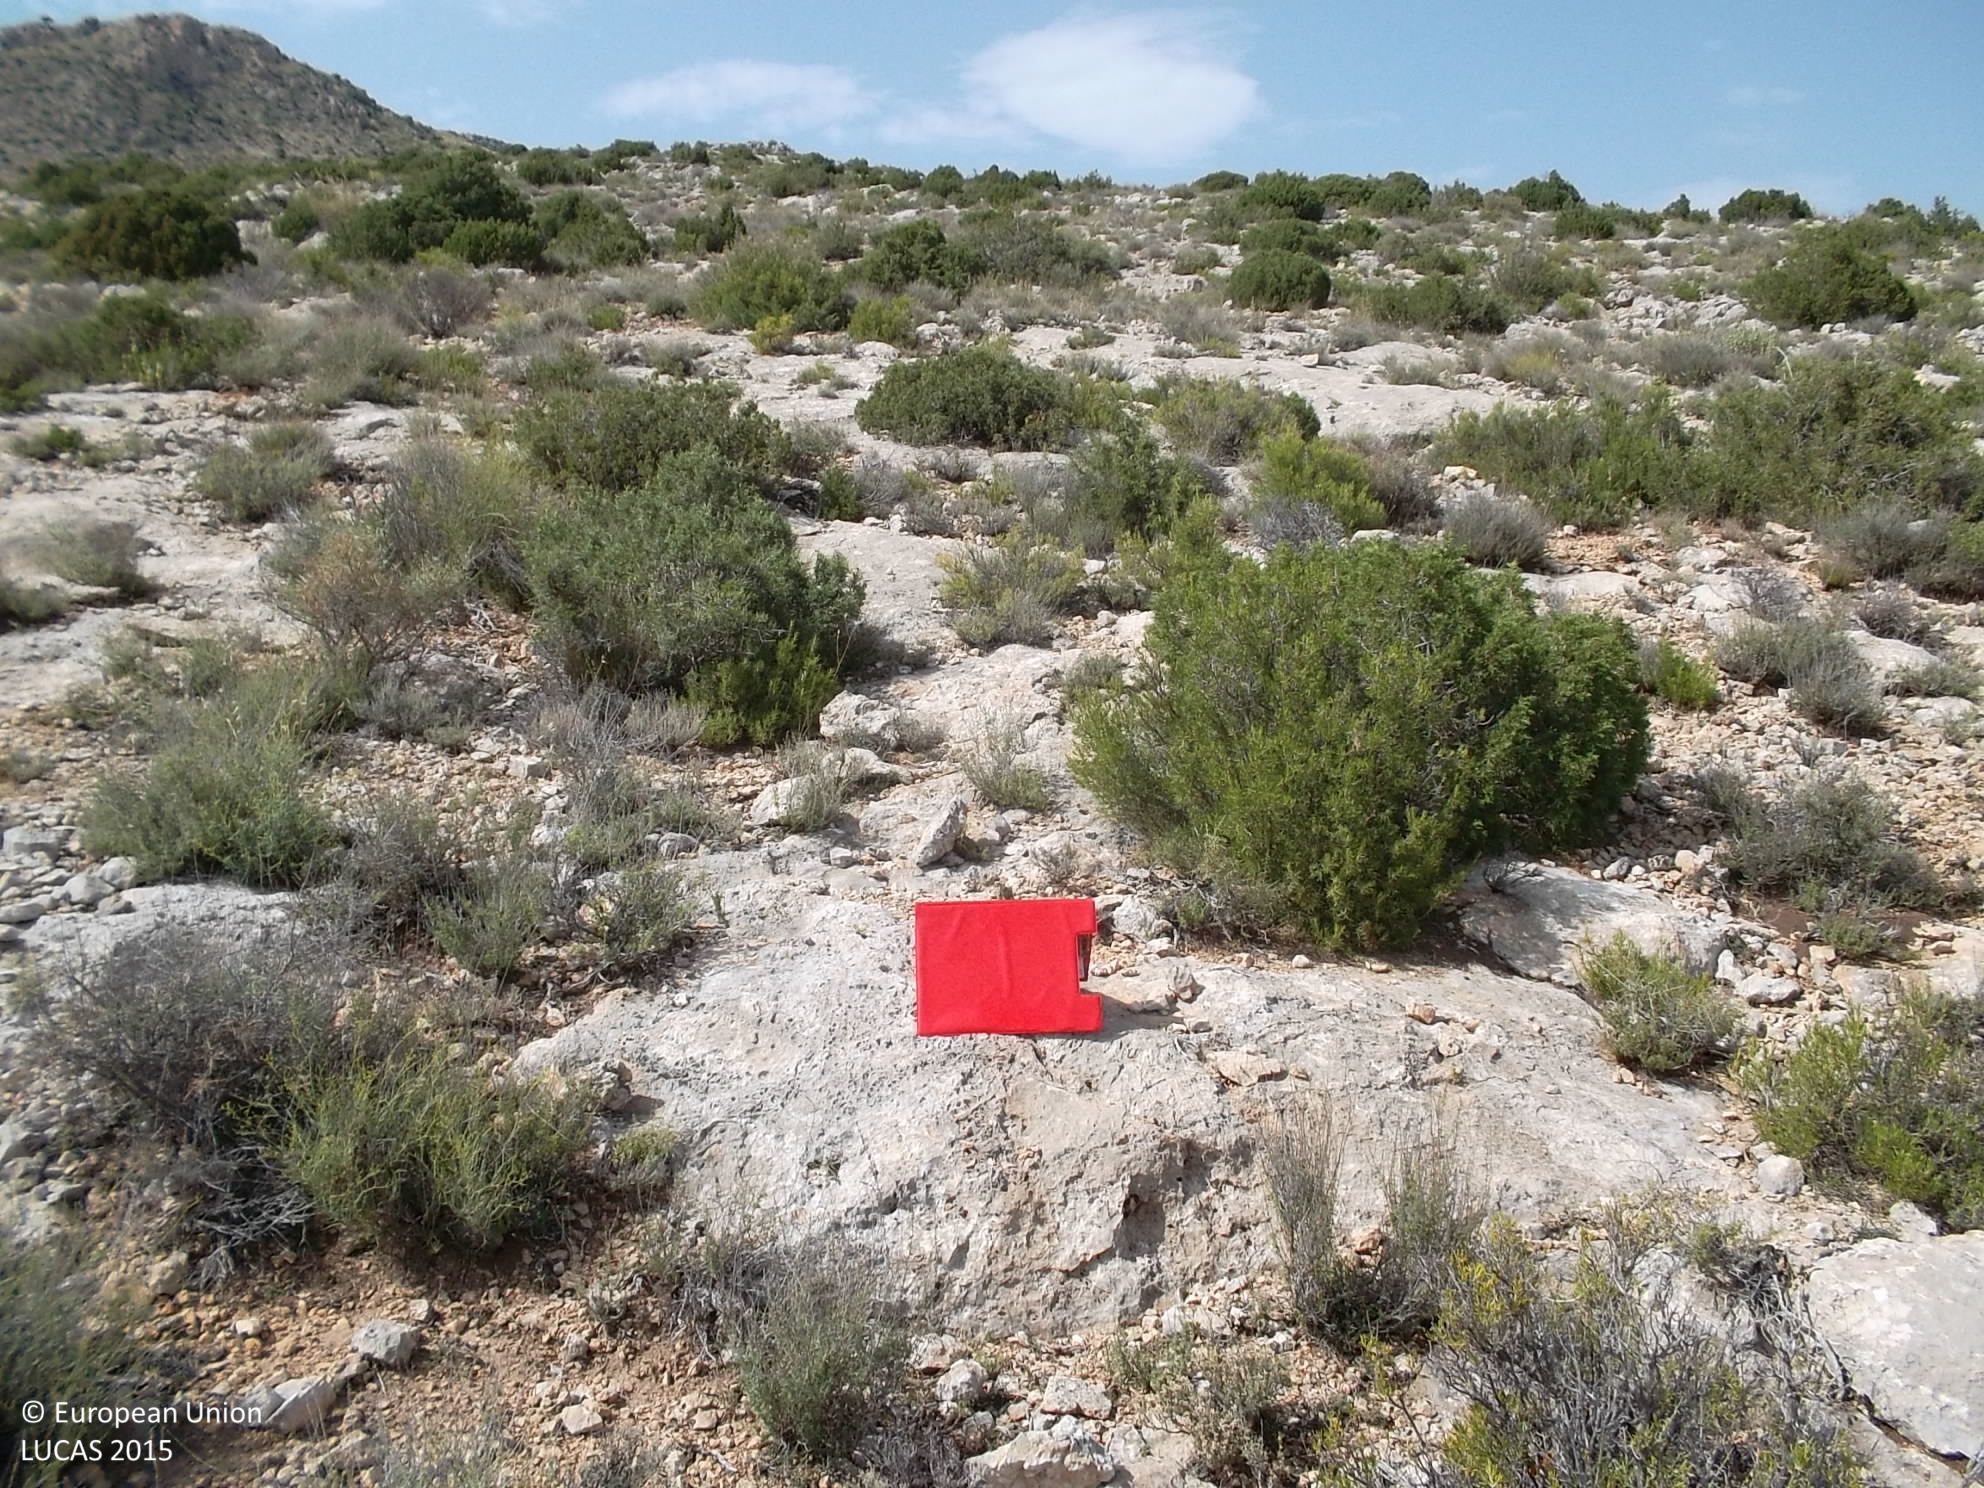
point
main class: Shrubland
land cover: Shrubland without tree cover
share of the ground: 50 - 75 %
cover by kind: shrubs 50 %, consolidated bare surface 30 %, herbaceous plants 20 %
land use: Semi-natural and natural areas not in use
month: July
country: ES
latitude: 37.9188
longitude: -2.4239
